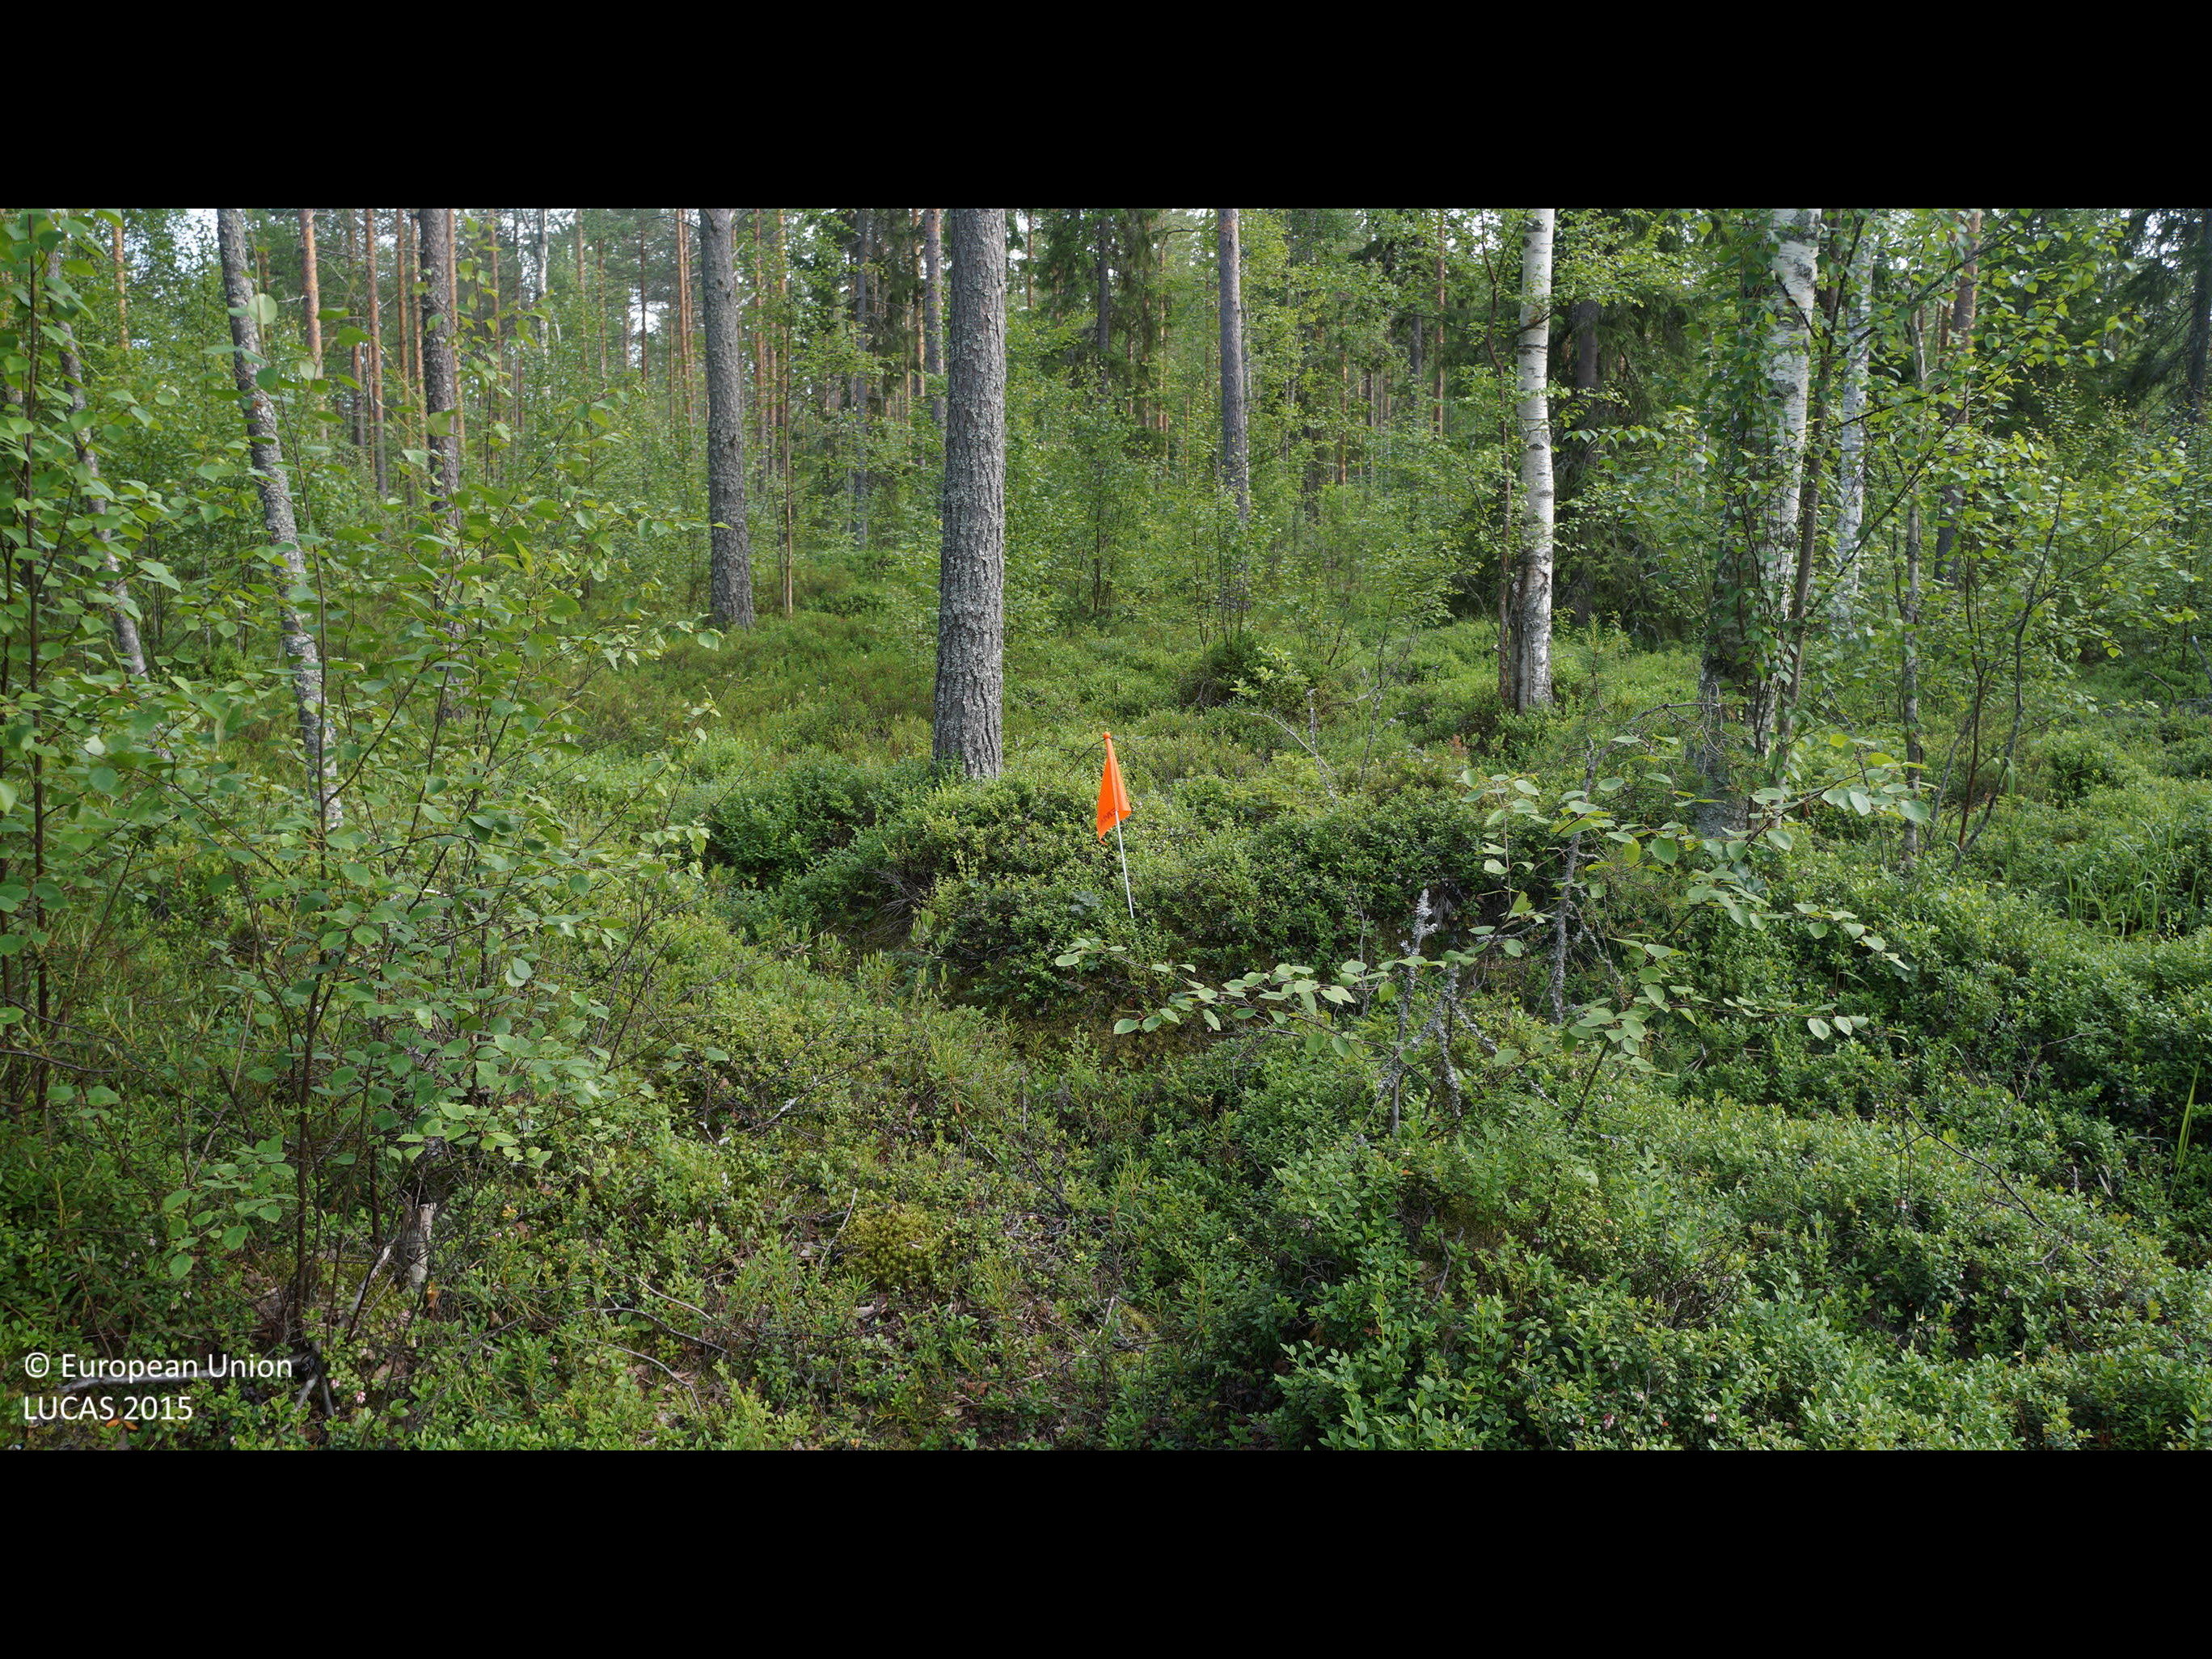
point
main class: Woodland
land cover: Other mixed woodland
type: boreal forest
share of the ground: 50 - 75 %
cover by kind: shrubs 40 %, coniferous forest trees 35 %, broadleaved forest trees 15 %, herbaceous plants 5 %, lichens and mosses 5 %
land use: Forestry
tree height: > 5 m
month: July
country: FI
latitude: 64.6702
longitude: 24.6718
